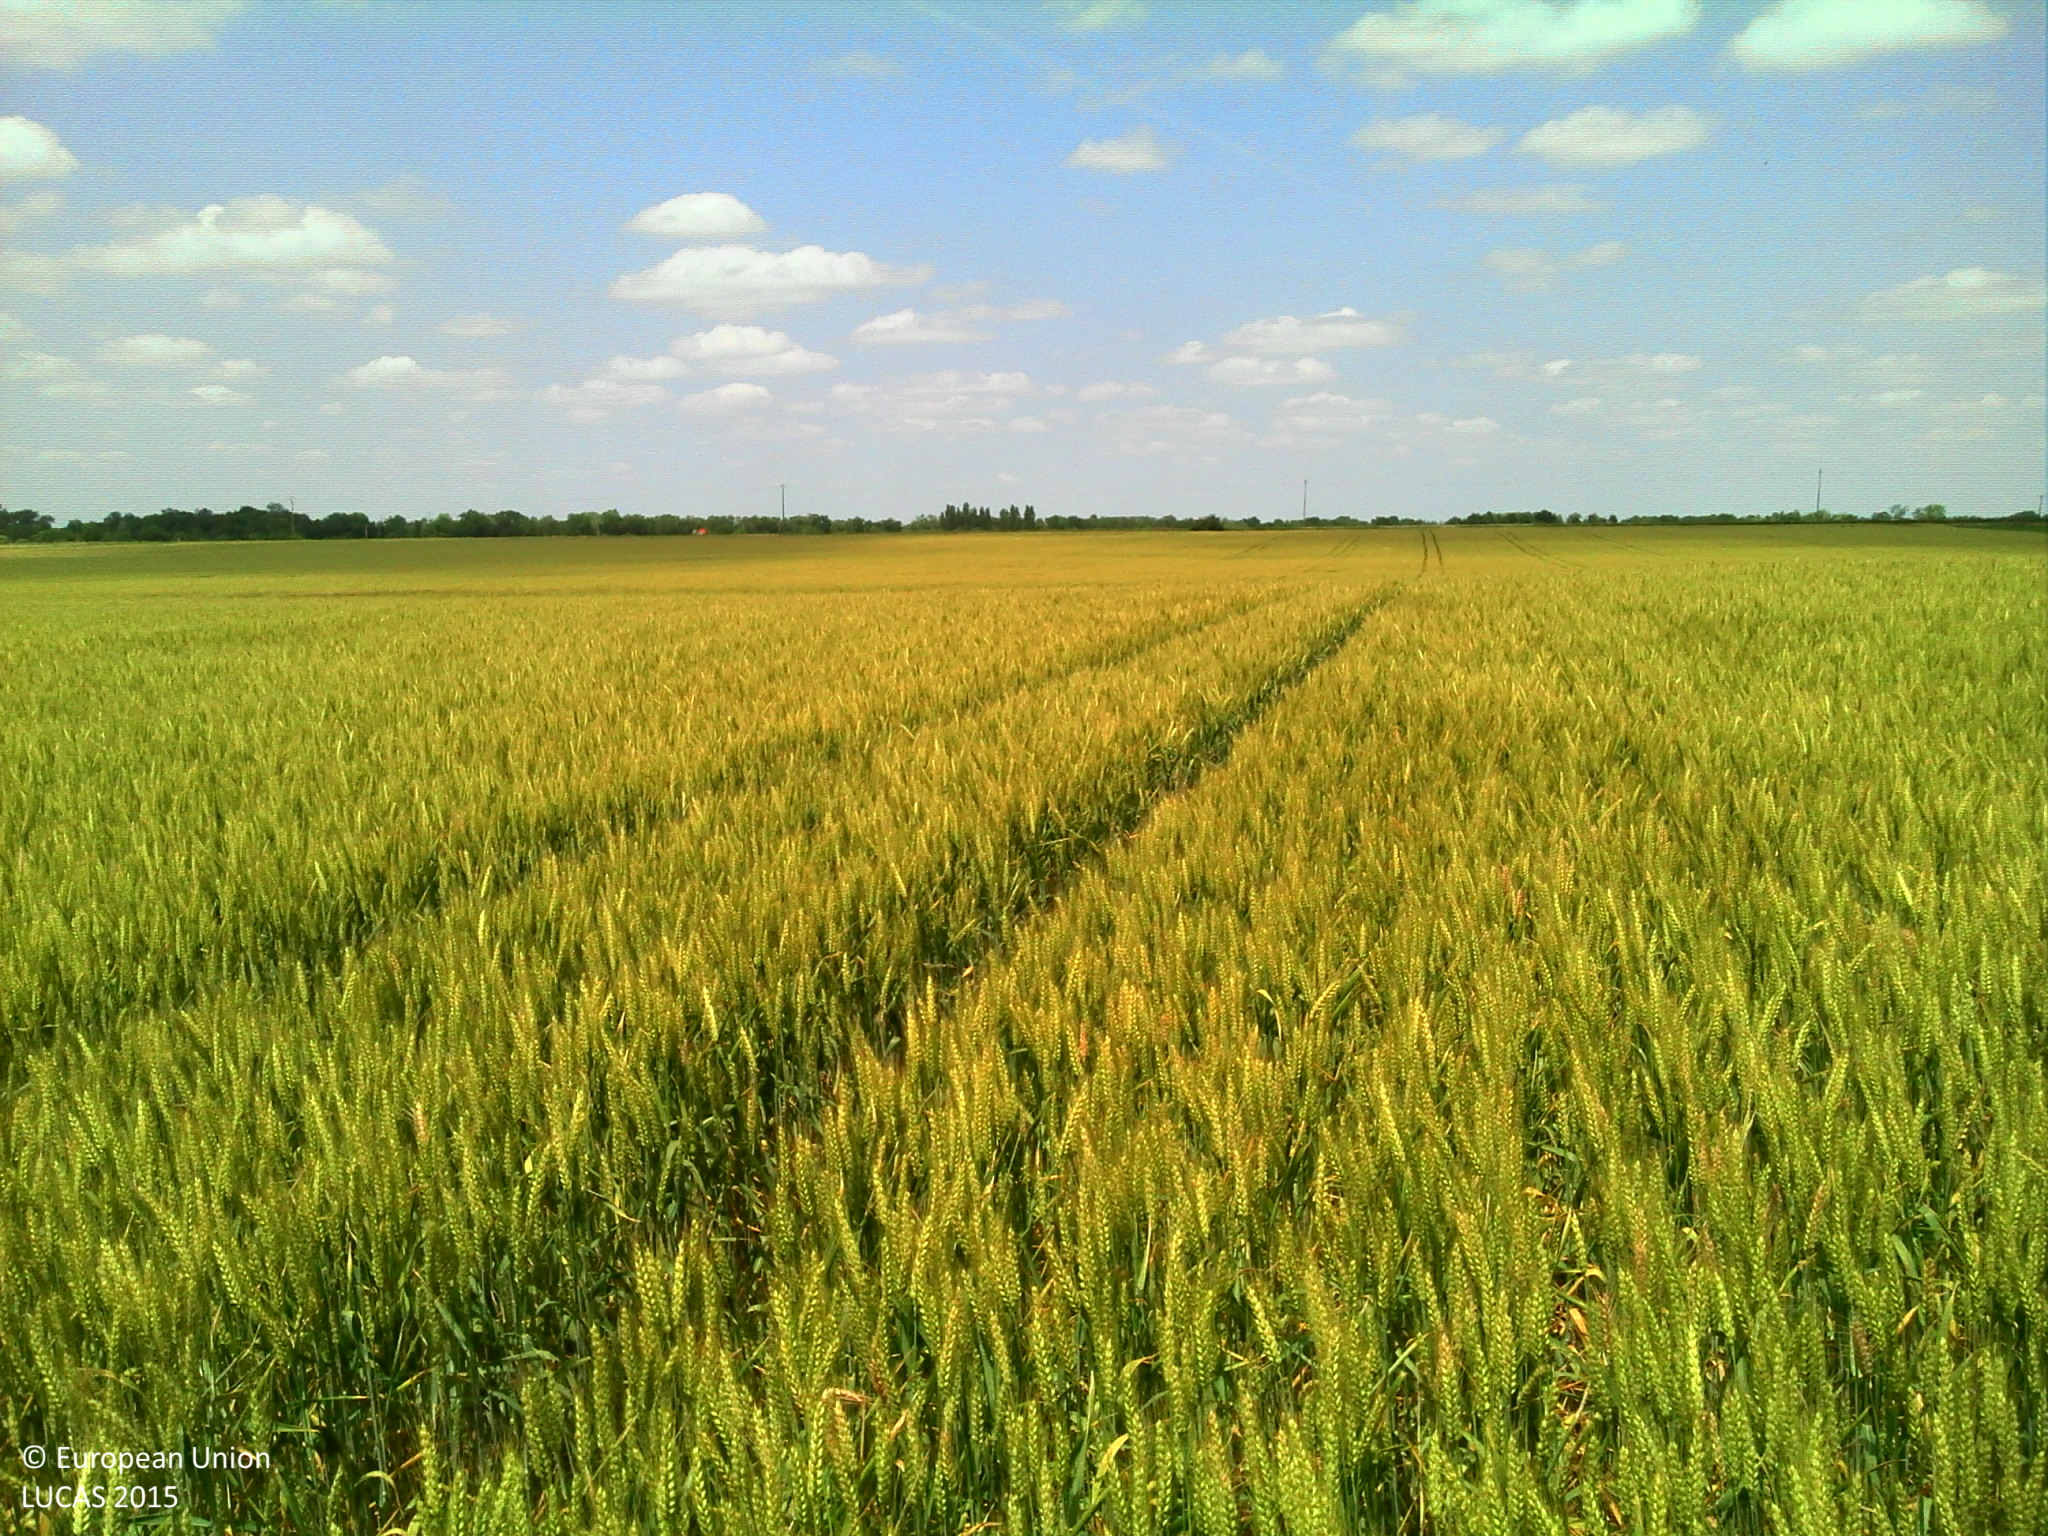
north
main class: Cropland
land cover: Durum wheat
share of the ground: > 75 %
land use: Agriculture (excluding fallow land and kitchen gardens)
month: June
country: FR
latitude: 46.2117
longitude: -1.0617
